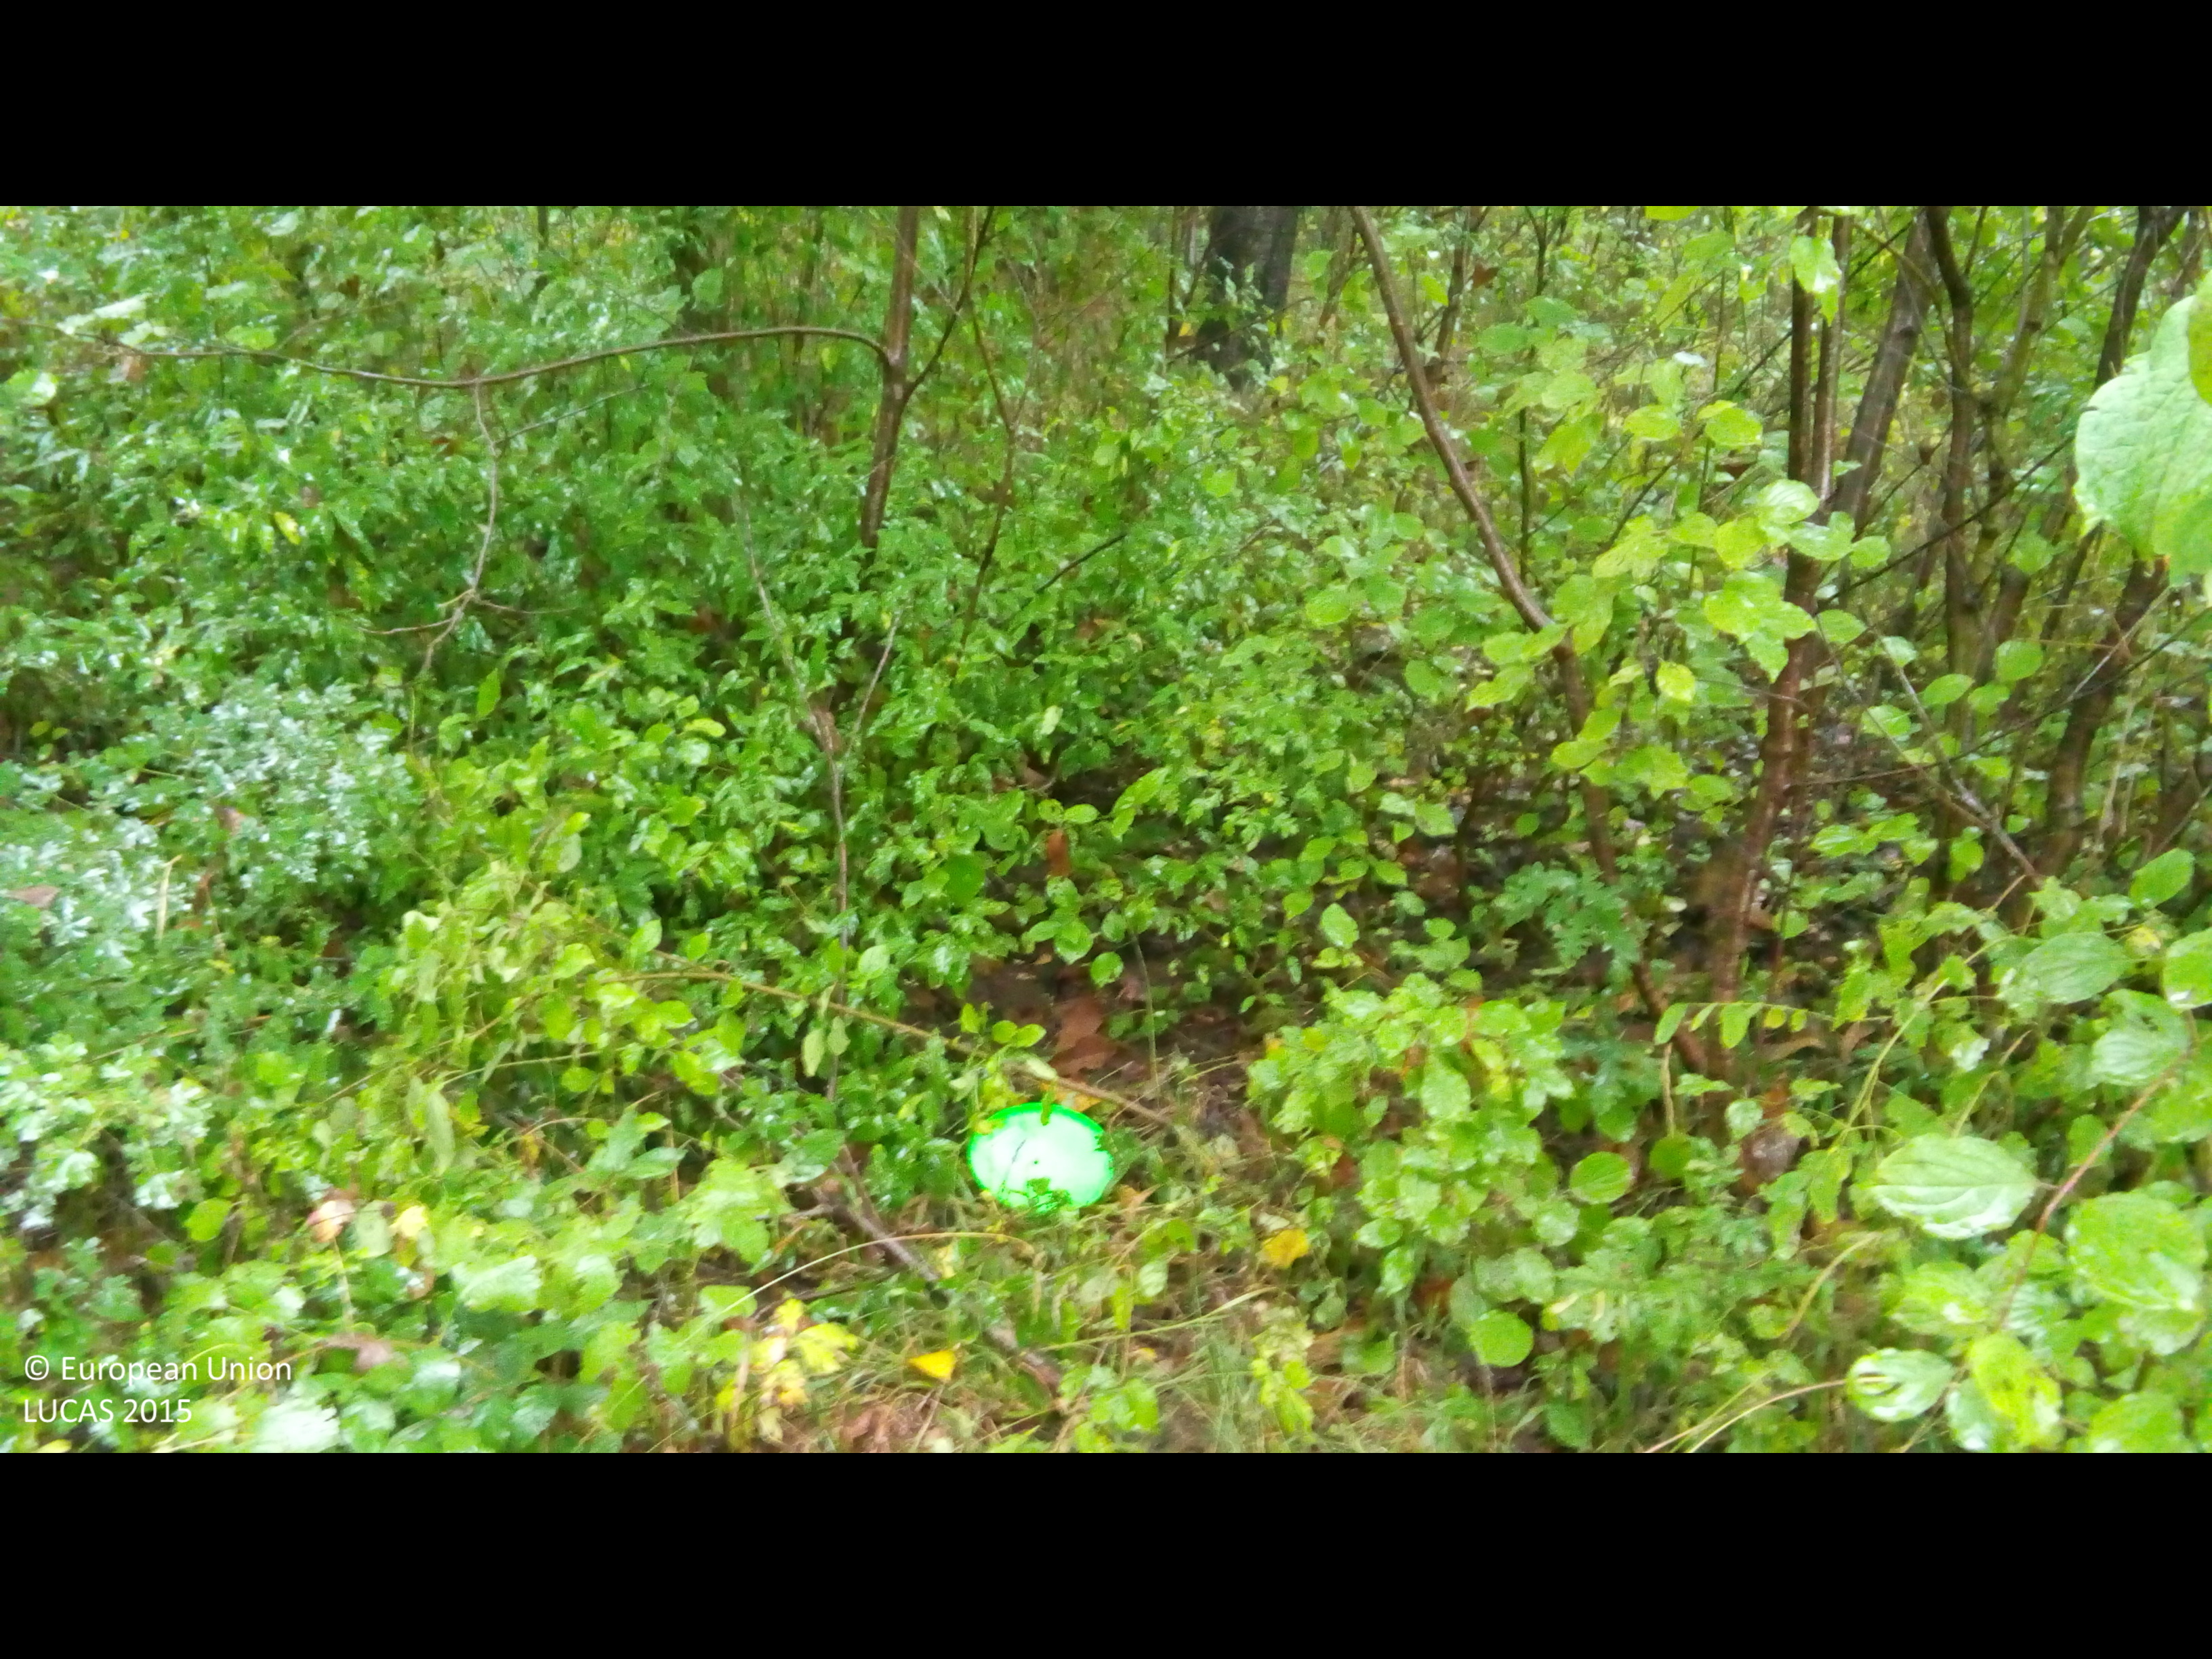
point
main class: Woodland
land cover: Broadleaved woodland
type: beech forest
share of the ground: > 75 %
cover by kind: broadleaved forest trees 90 %, shrubs 5 %, herbaceous plants 5 %
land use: Forestry
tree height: > 5 m
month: October
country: BG
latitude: 42.5784
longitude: 23.4245
